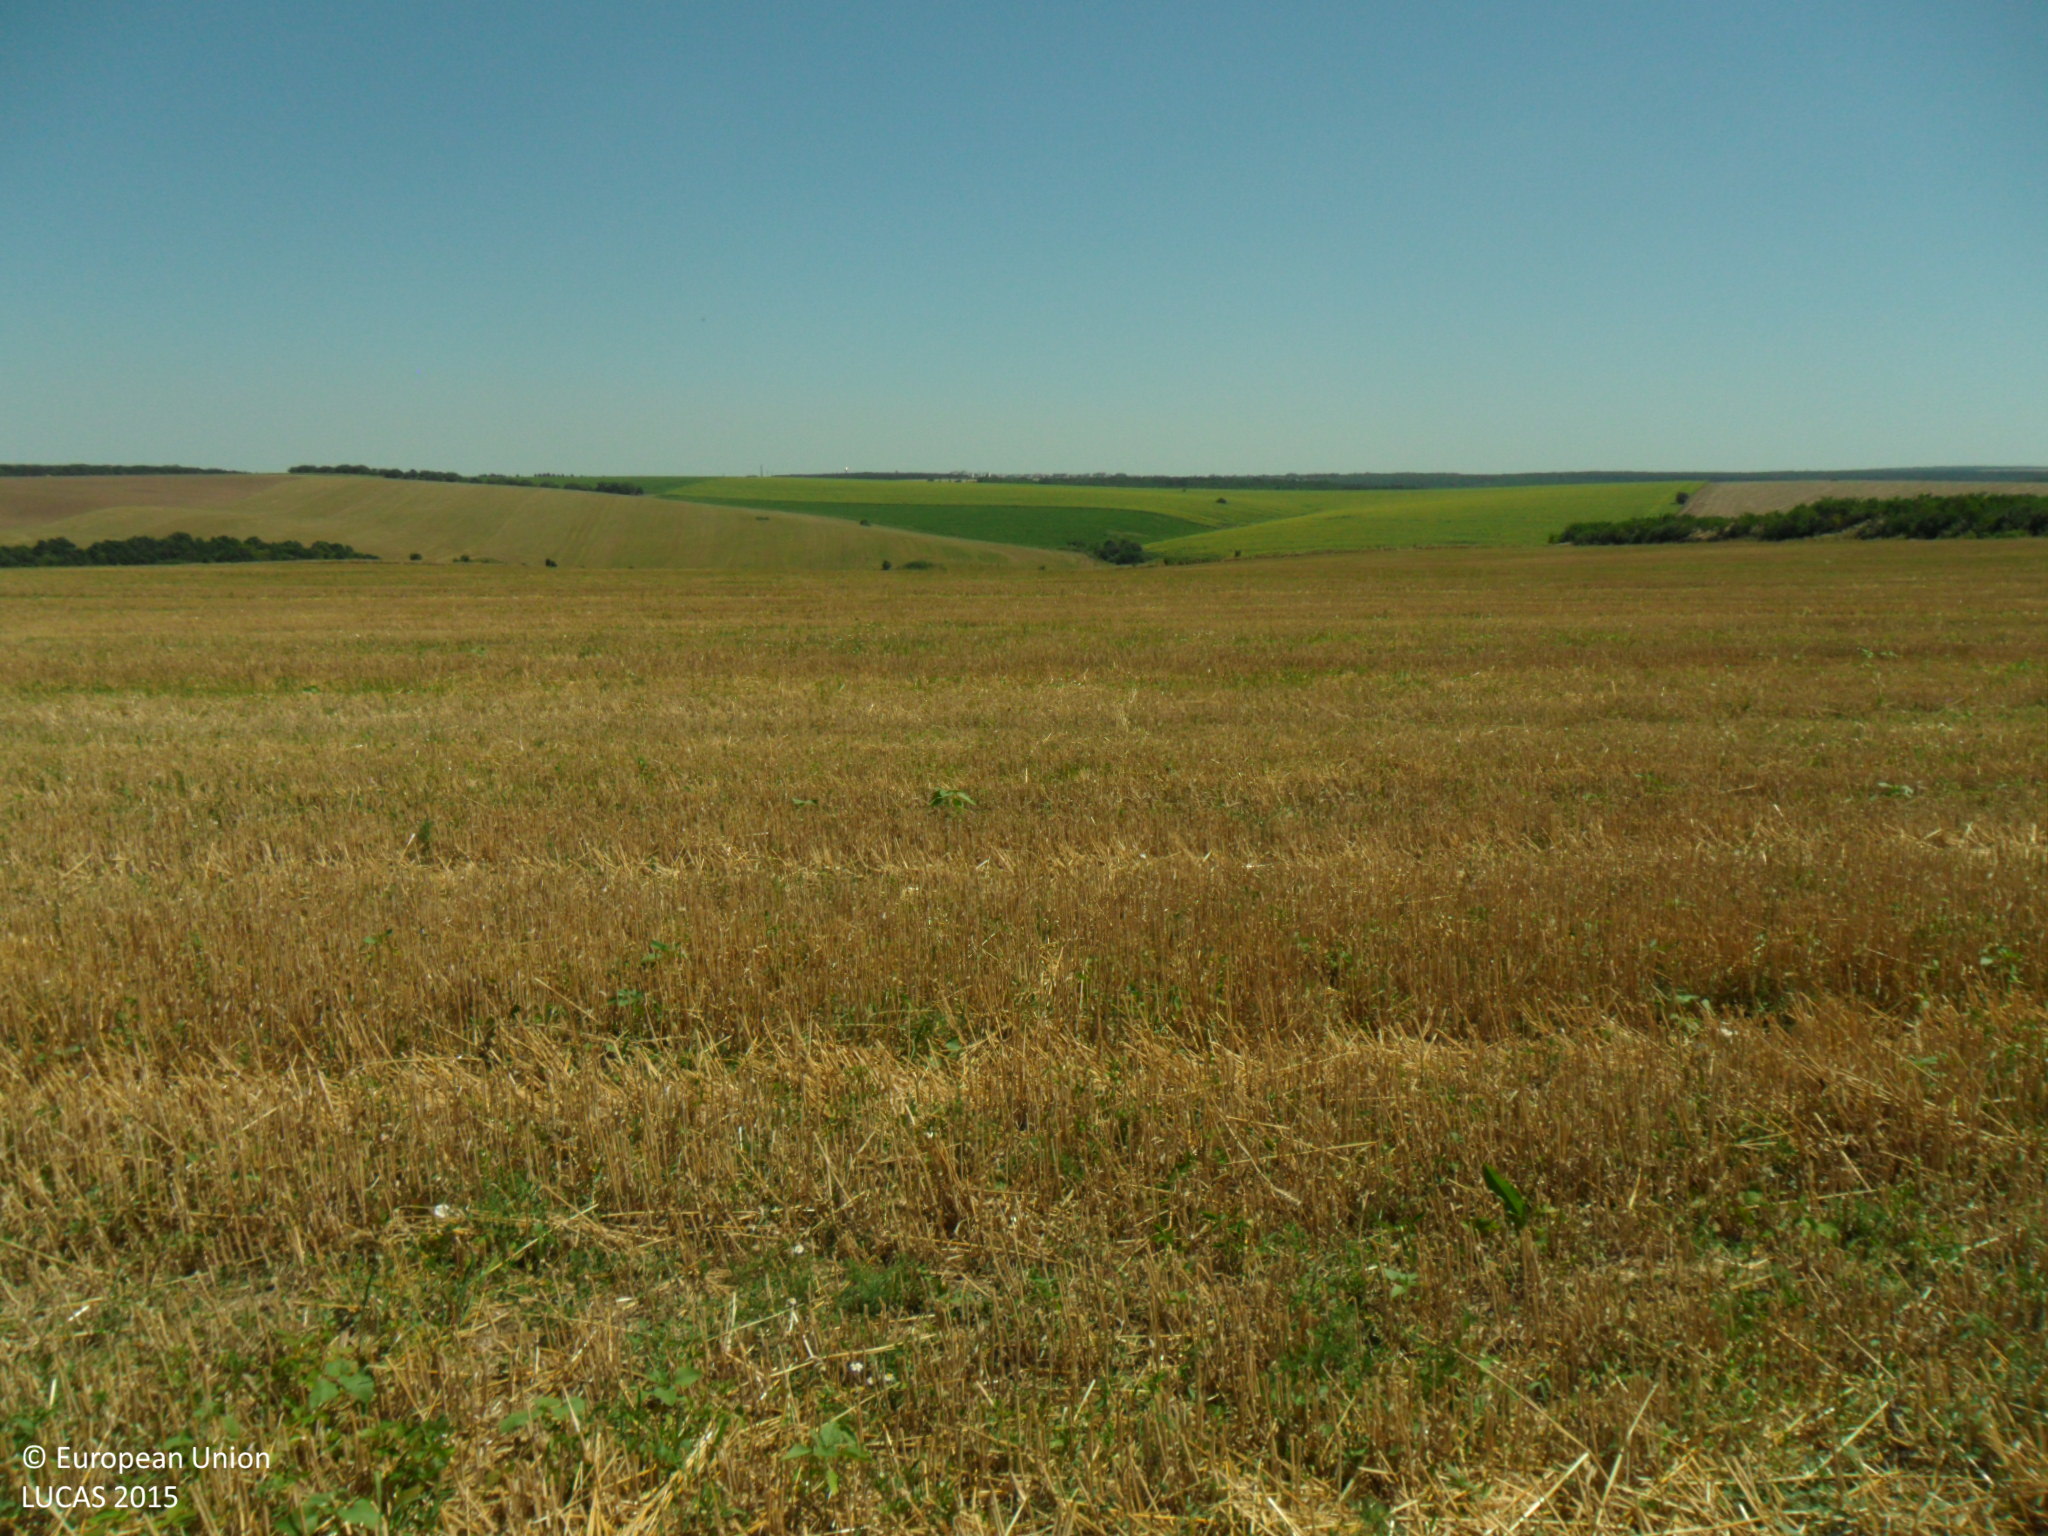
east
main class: Cropland
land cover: Common wheat
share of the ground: 50 - 75 %
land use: Agriculture (excluding fallow land and kitchen gardens)
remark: Harvested field
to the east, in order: Common wheat
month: July
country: BG
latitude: 43.8025
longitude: 26.4265
